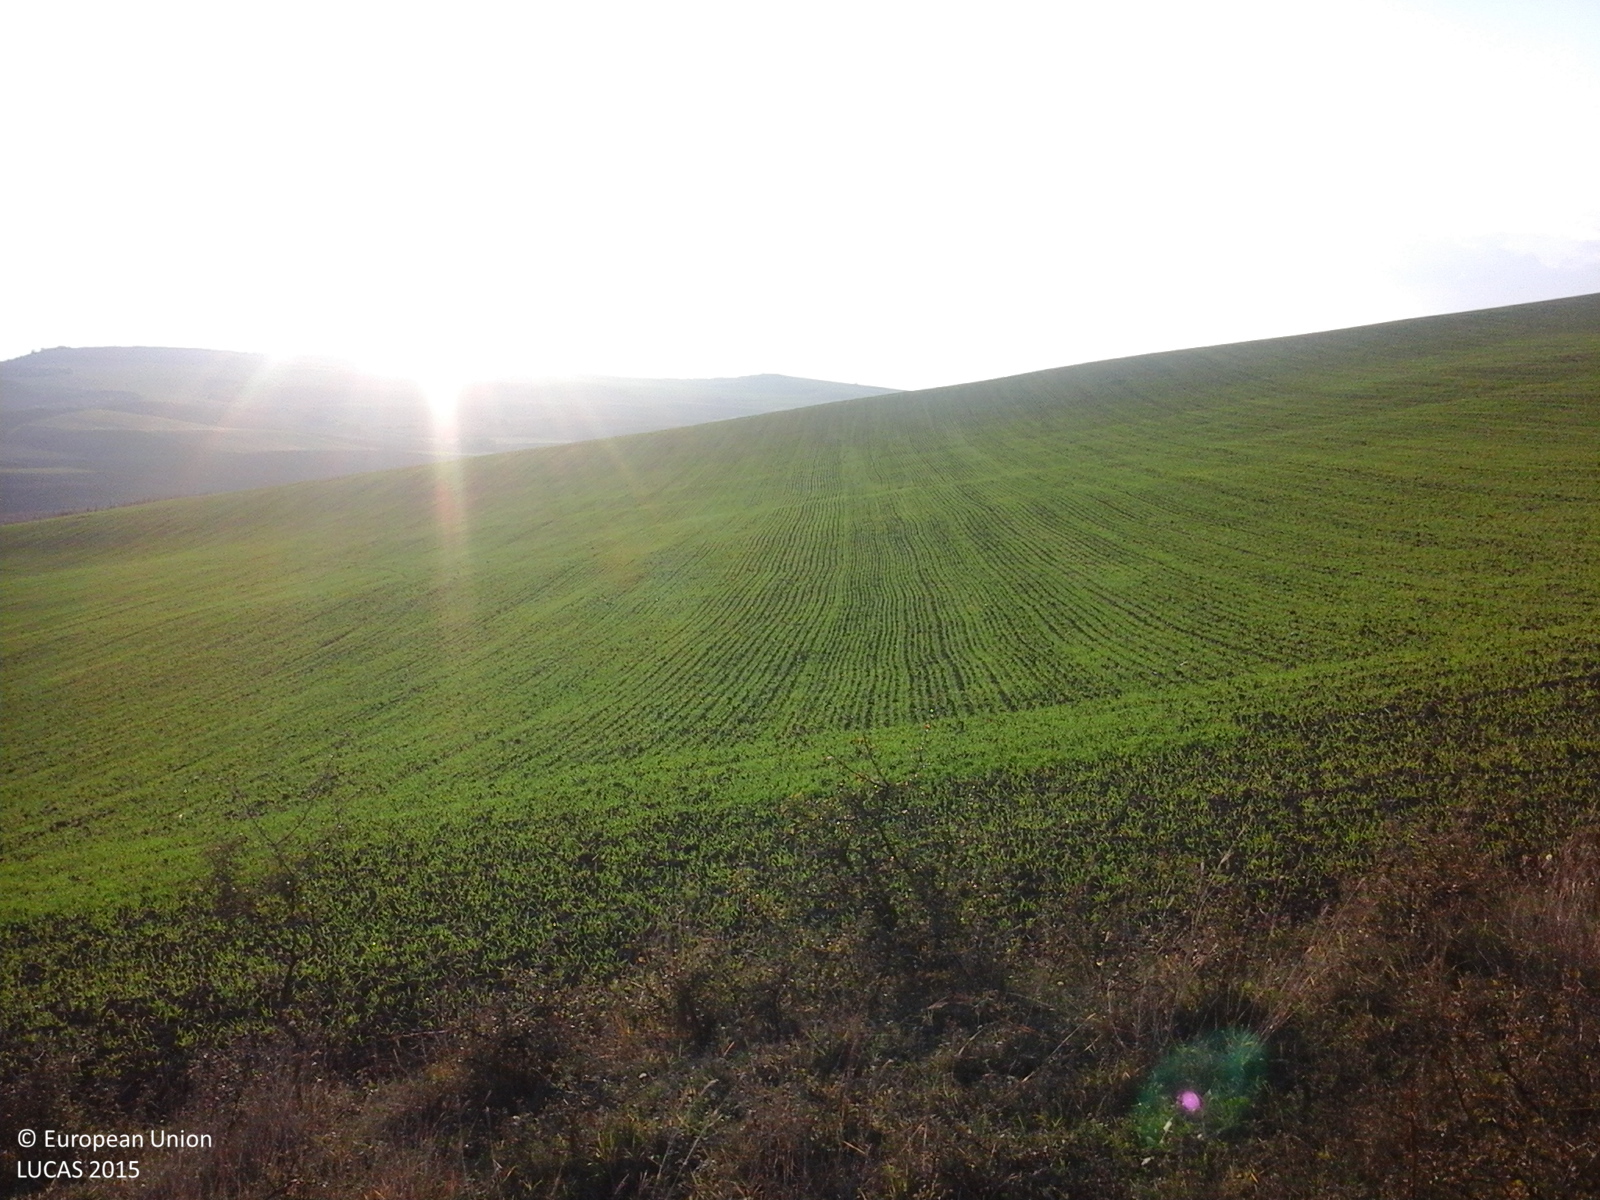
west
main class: Grassland
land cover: Spontaneously vegetated surfaces
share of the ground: > 75 %
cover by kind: herbaceous plants 100 %
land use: Agriculture (excluding fallow land and kitchen gardens)
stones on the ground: < 10 %
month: October
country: RO
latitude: 46.4892
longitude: 24.3755
